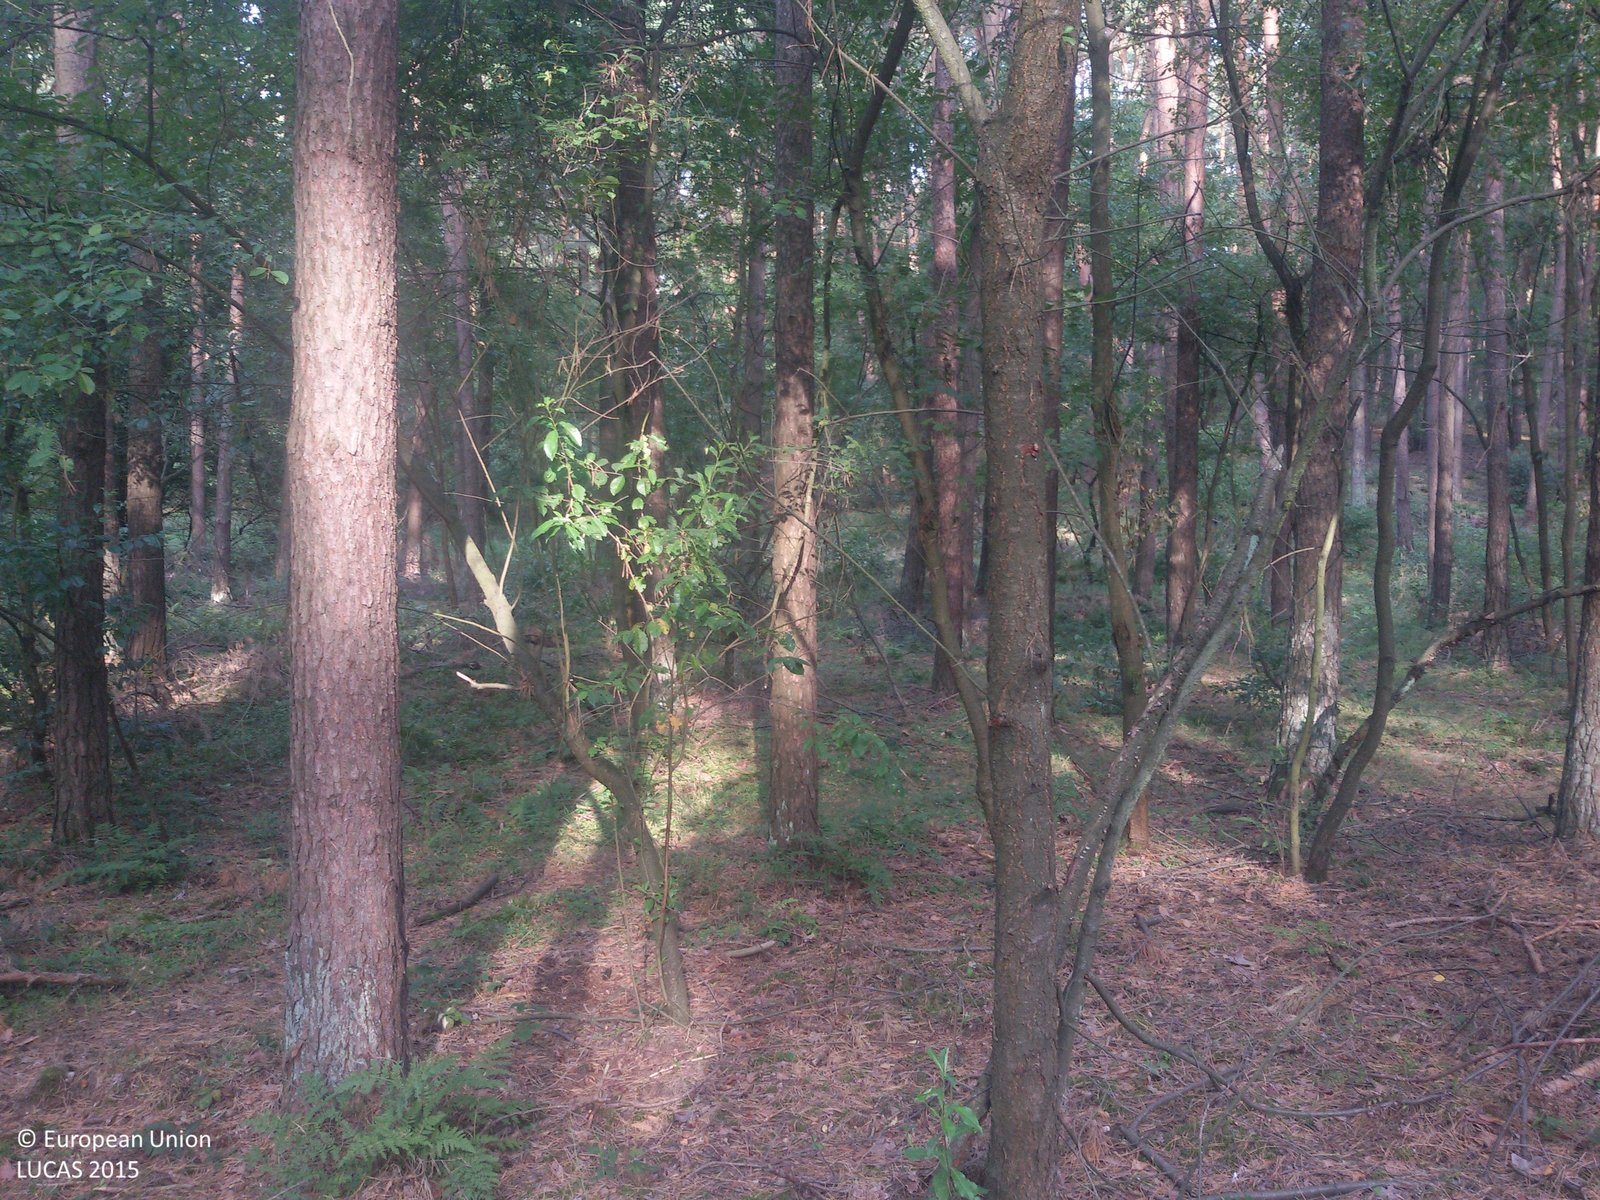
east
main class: Woodland
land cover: Pine dominated mixed woodland
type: hemiboreal forest and nemoral coniferous forest and mixed broadleaved-coniferous forest
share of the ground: > 75 %
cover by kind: coniferous forest trees 55 %, broadleaved forest trees 25 %, shrubs 10 %, herbaceous plants 5 %, unconsolidated bare surface 5 %
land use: Forestry
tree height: > 5 m
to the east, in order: Pine dominated mixed woodland; Tracks; Pine dominated mixed woodland; Railways; Pine dominated mixed woodland
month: September
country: PL
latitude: 52.4502
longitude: 18.0054
